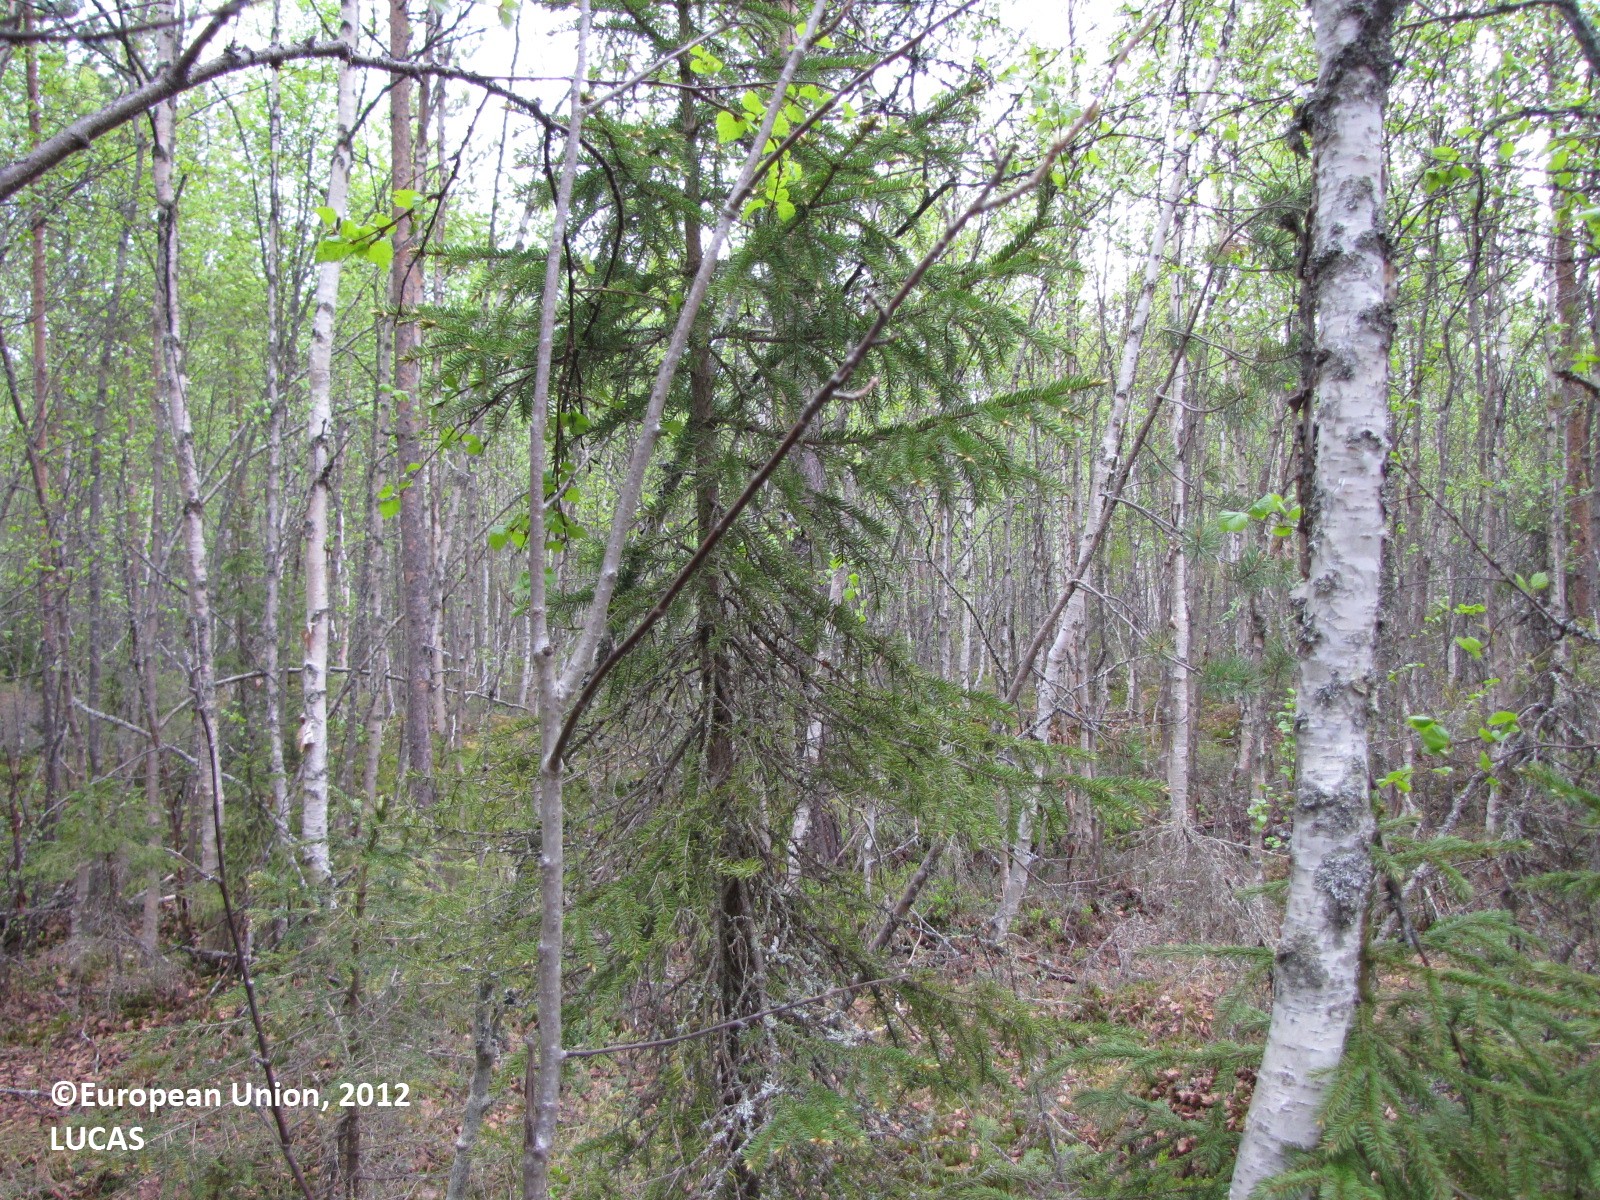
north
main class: Woodland
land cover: Other mixed woodland
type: boreal forest
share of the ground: 50 - 75 %
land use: Forestry
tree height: > 5 m
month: June
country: FI
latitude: 65.9015
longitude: 24.7405
